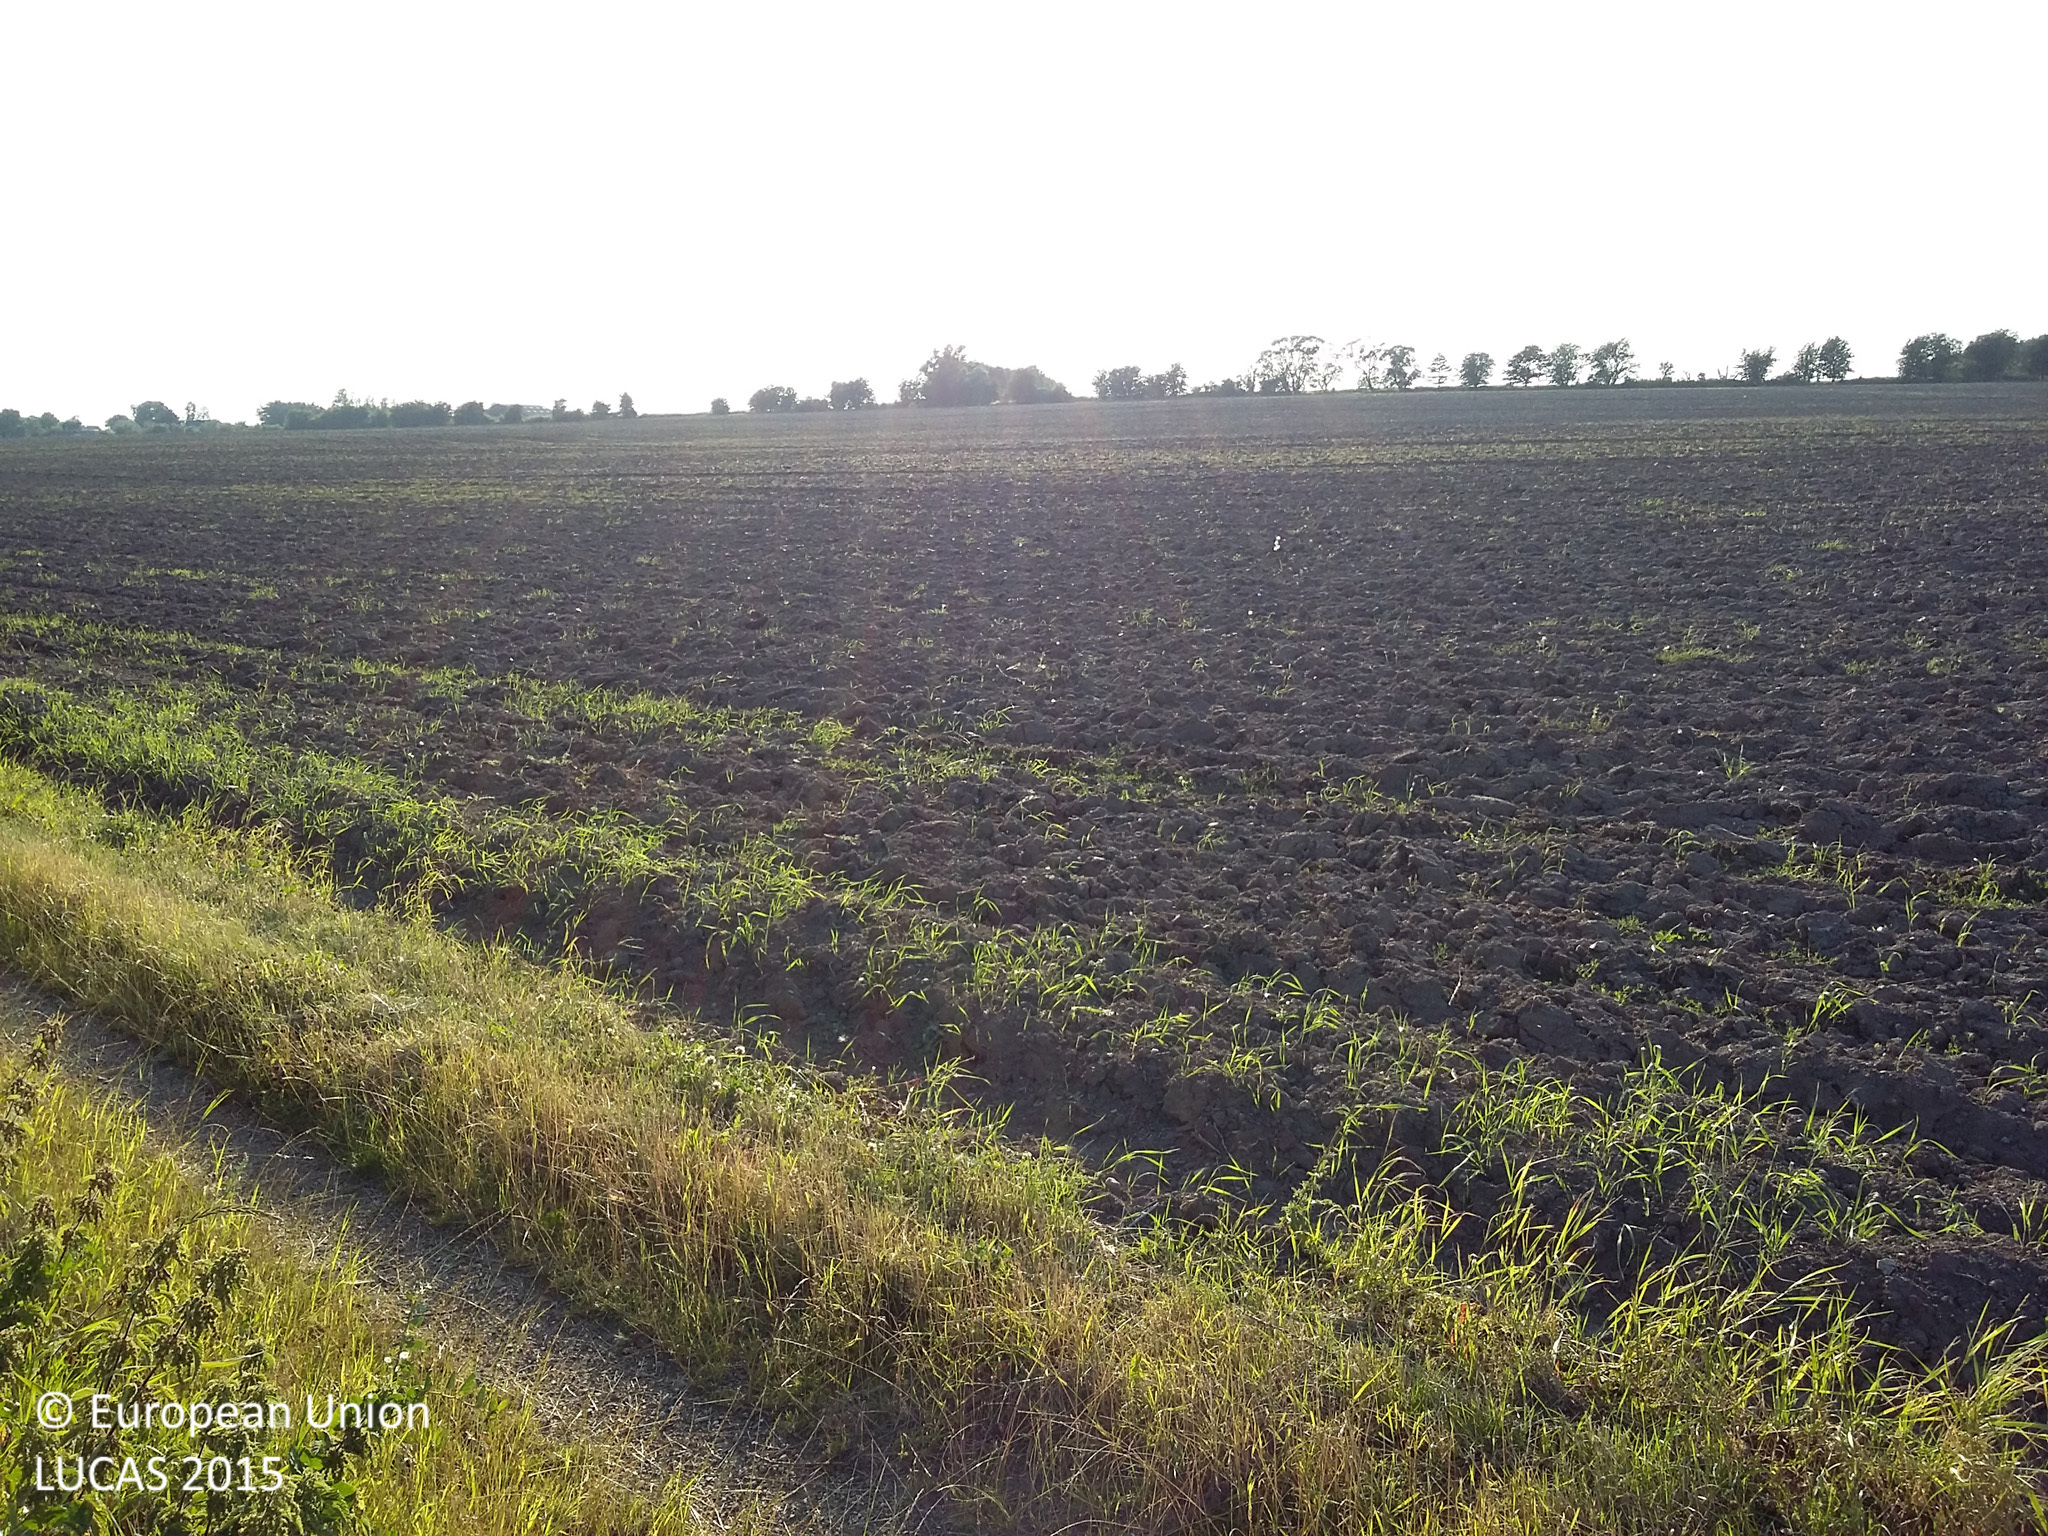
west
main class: Woodland
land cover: Broadleaved woodland
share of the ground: 25 - 50 %
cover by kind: herbaceous plants 60 %, broadleaved forest trees 40 %
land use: Agriculture (excluding fallow land and kitchen gardens)
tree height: > 5 m
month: August
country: DK
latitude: 55.6294
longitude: 12.2059
